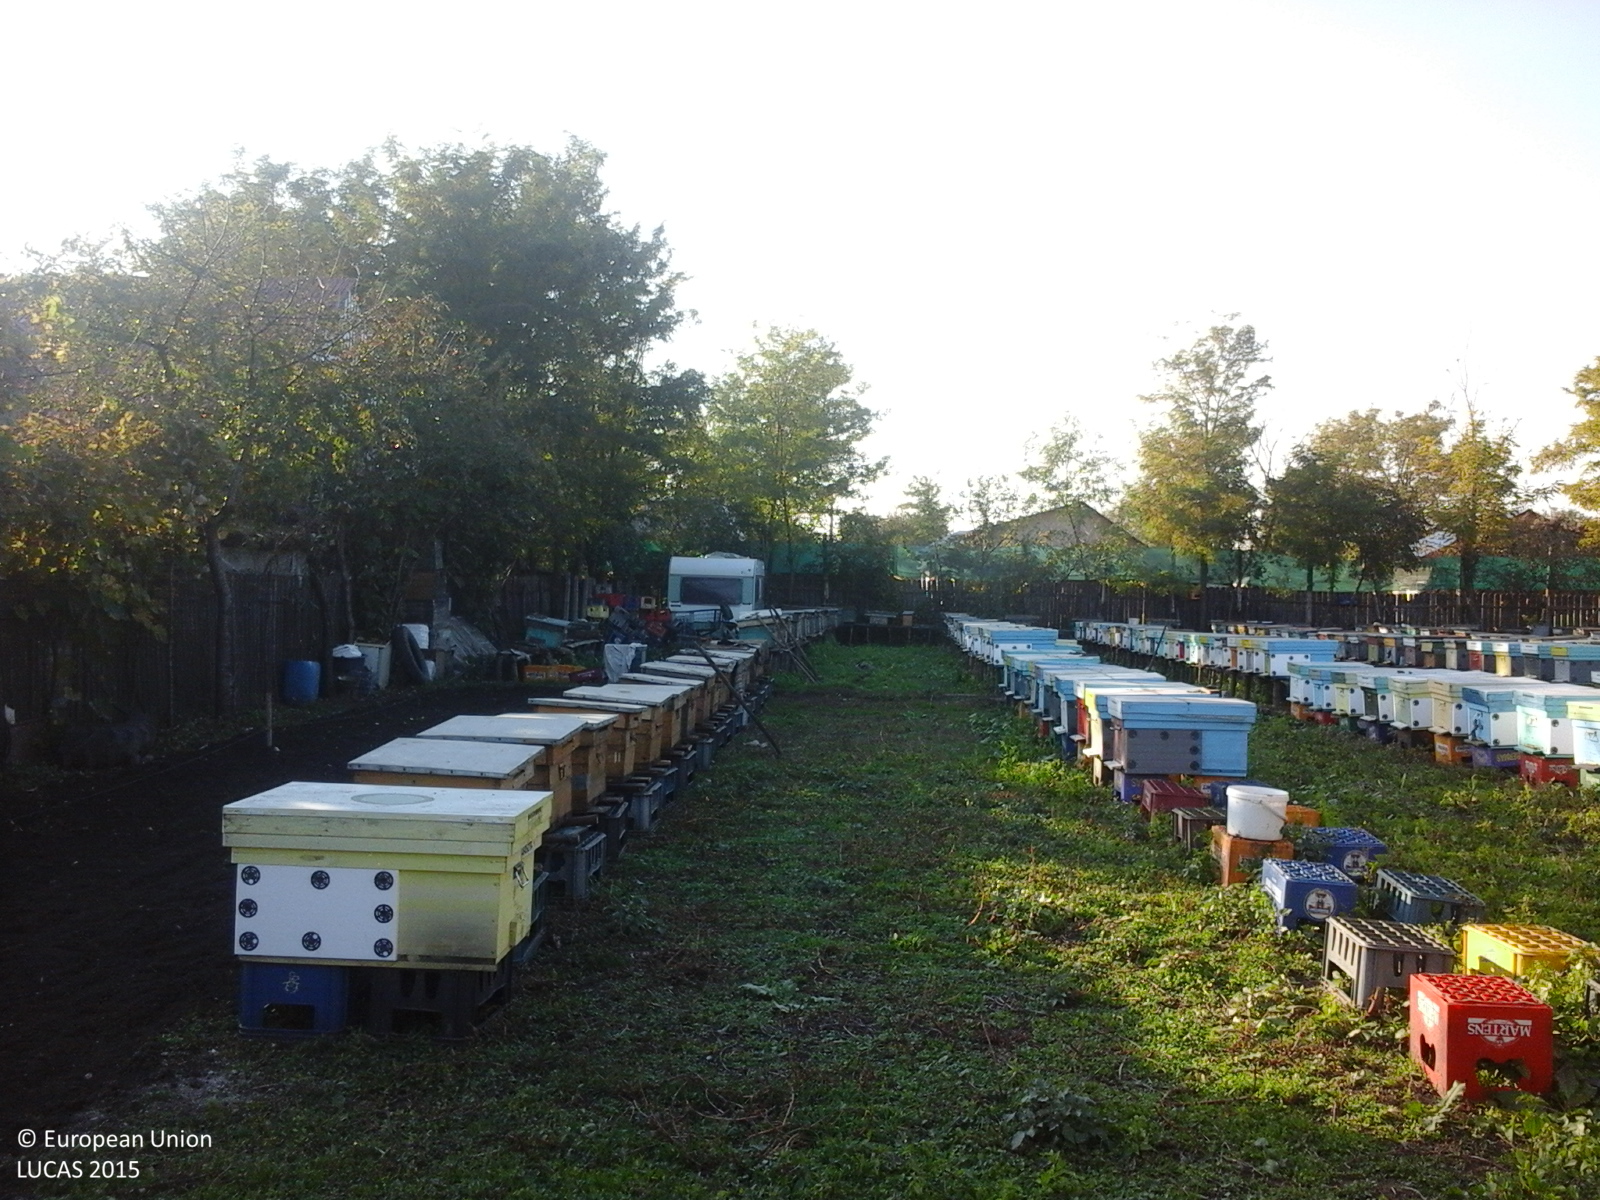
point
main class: Grassland
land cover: Grassland without tree/shrub cover
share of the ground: > 75 %
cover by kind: herbaceous plants 100 %
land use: Other primary production
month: October
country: RO
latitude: 45.2111
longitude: 27.0335
